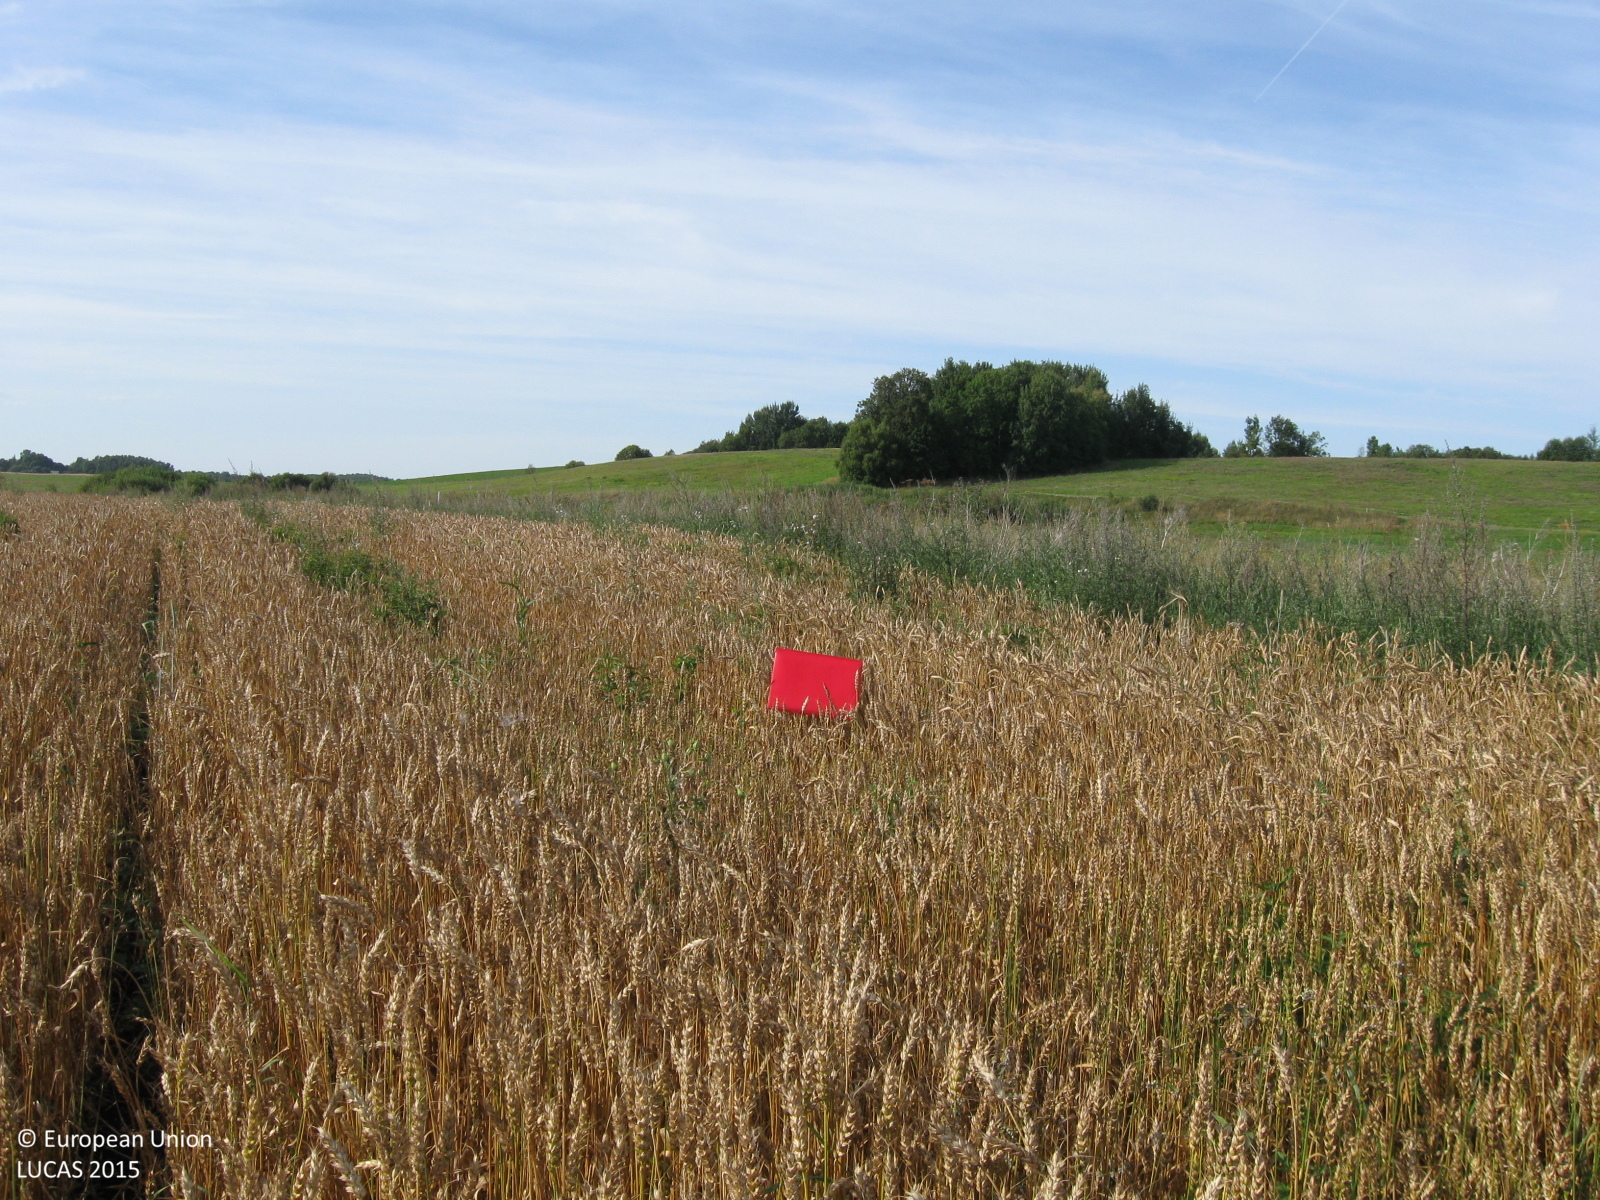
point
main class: Cropland
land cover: Common wheat
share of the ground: > 75 %
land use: Agriculture (excluding fallow land and kitchen gardens)
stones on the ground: < 10 %
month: August
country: LT
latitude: 55.4956
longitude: 22.5509
